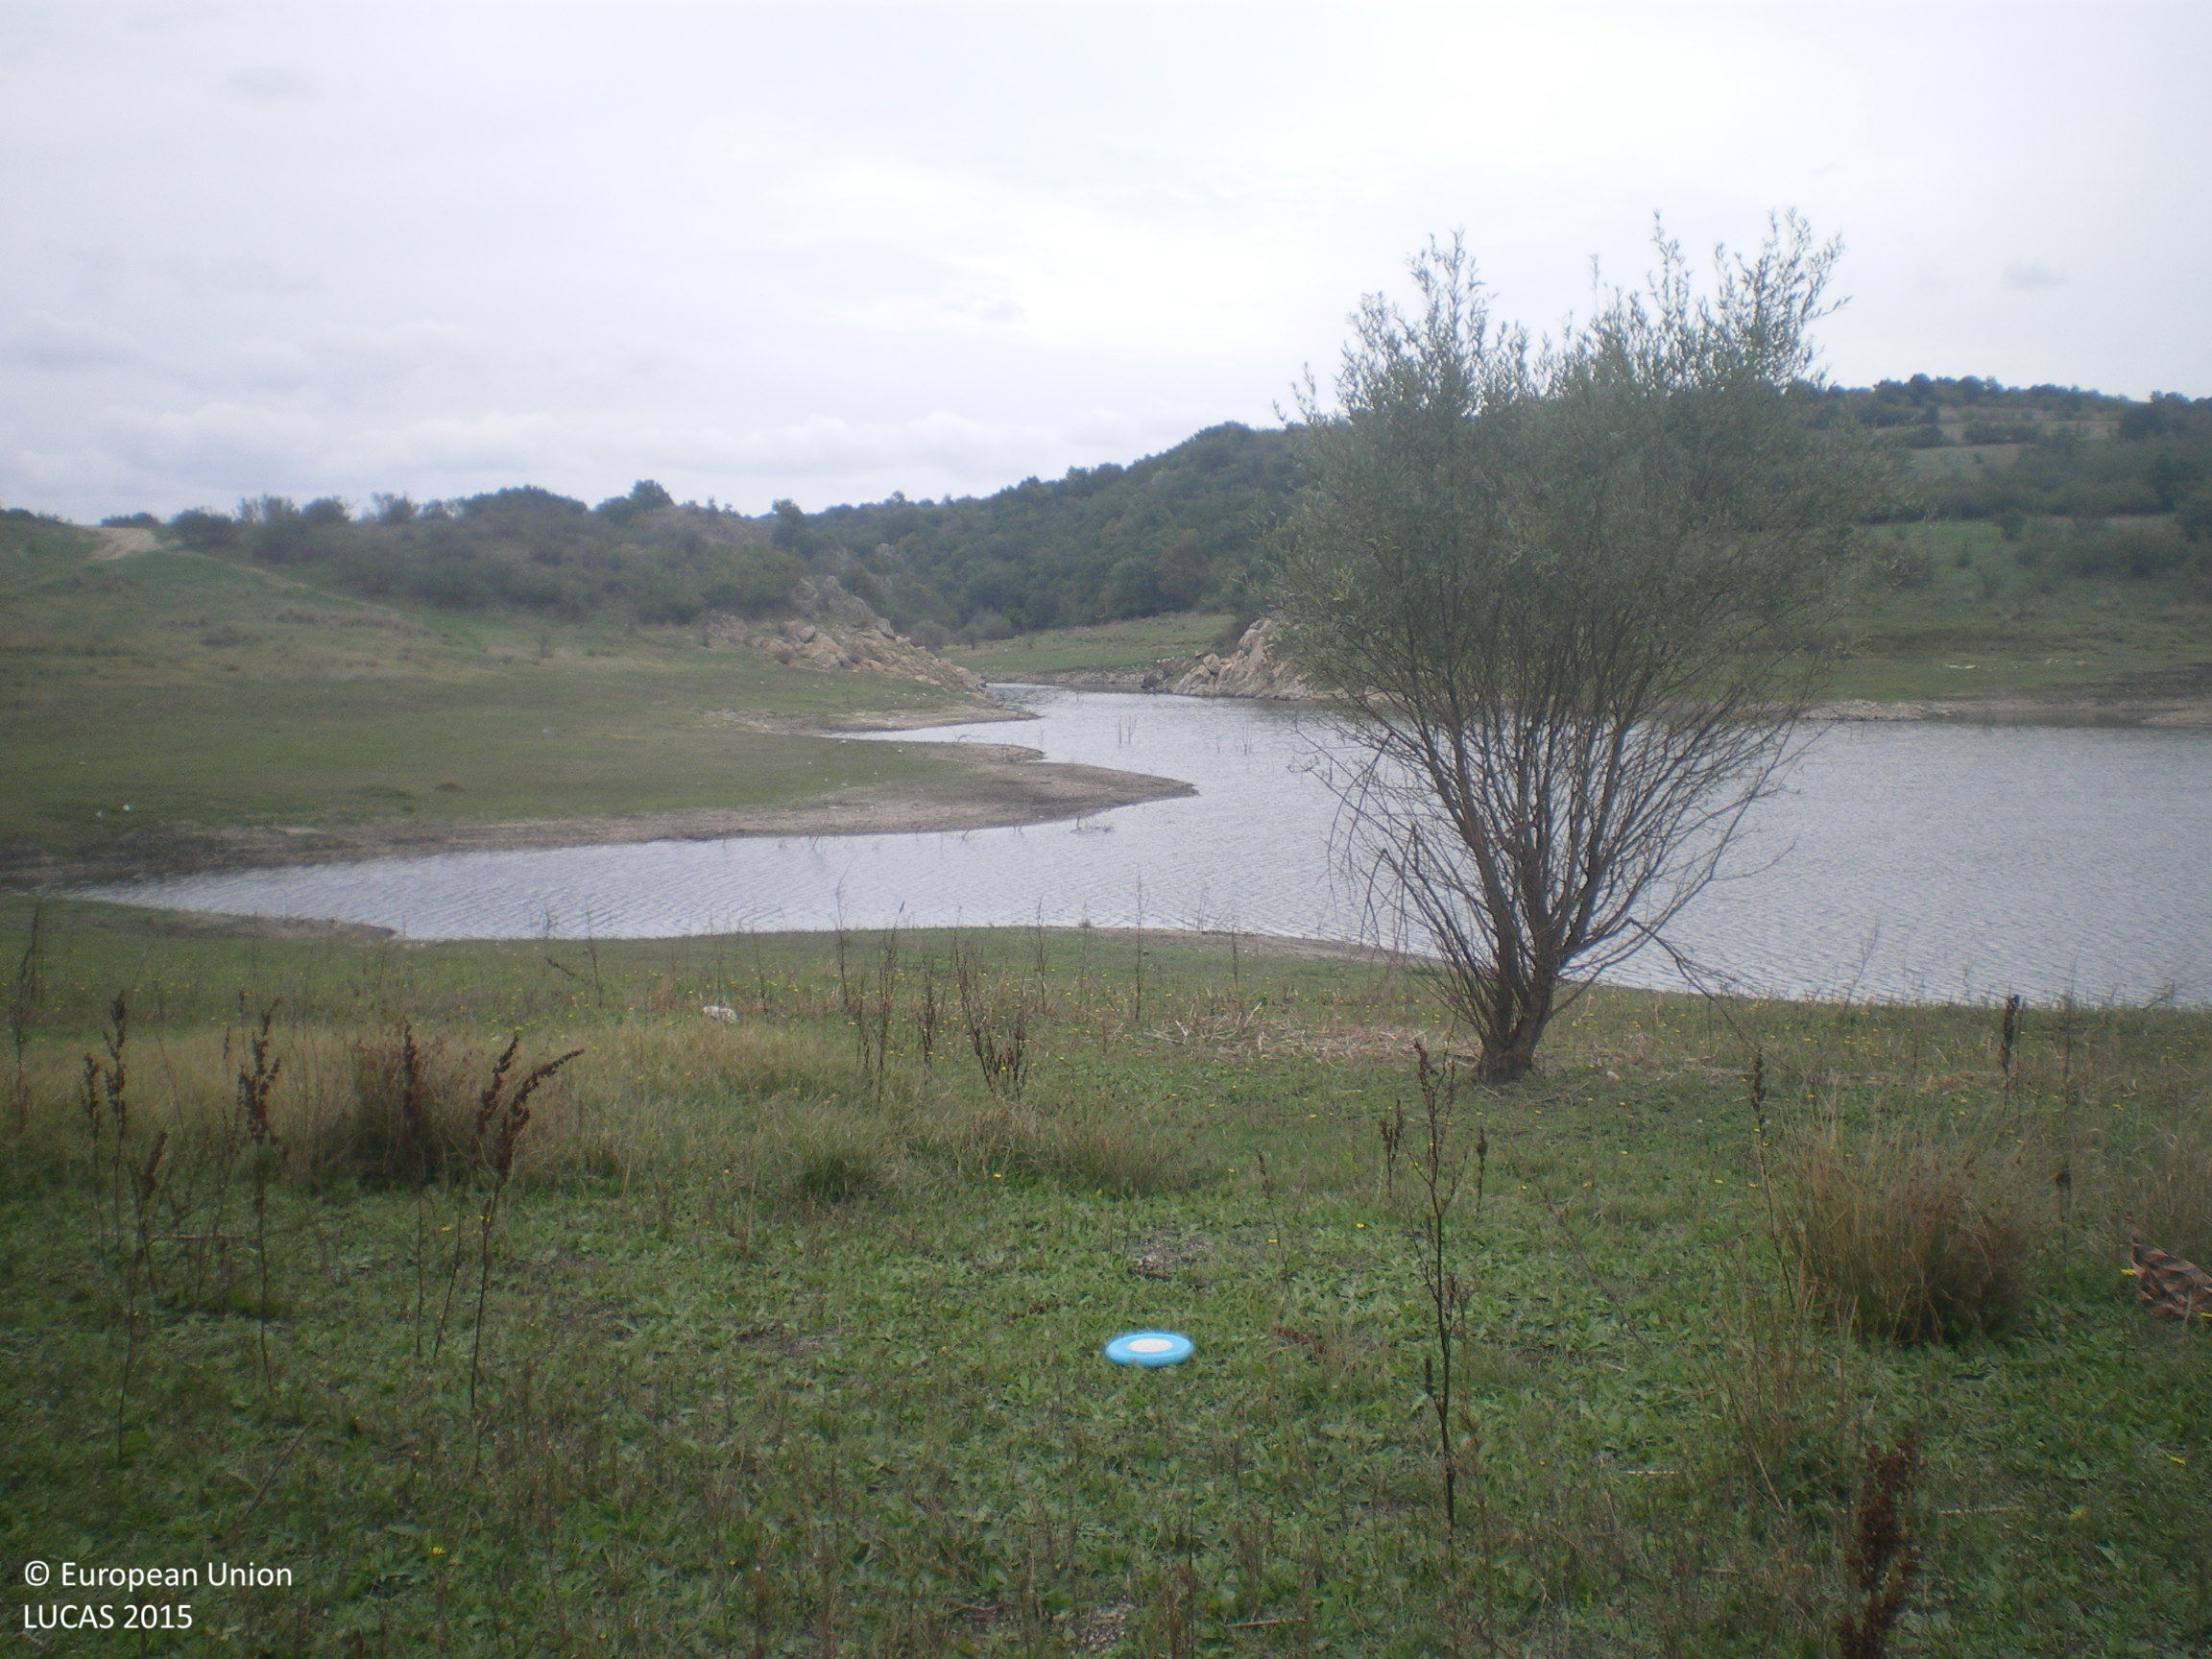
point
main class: Grassland
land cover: Grassland with sparse tree/shrub cover
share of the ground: > 75 %
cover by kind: herbaceous plants 90 %, broadleaved forest trees 5 %, shrubs 5 %
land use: Semi-natural and natural areas not in use
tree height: > 5 m
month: October
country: BG
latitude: 41.9371
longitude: 26.0309
